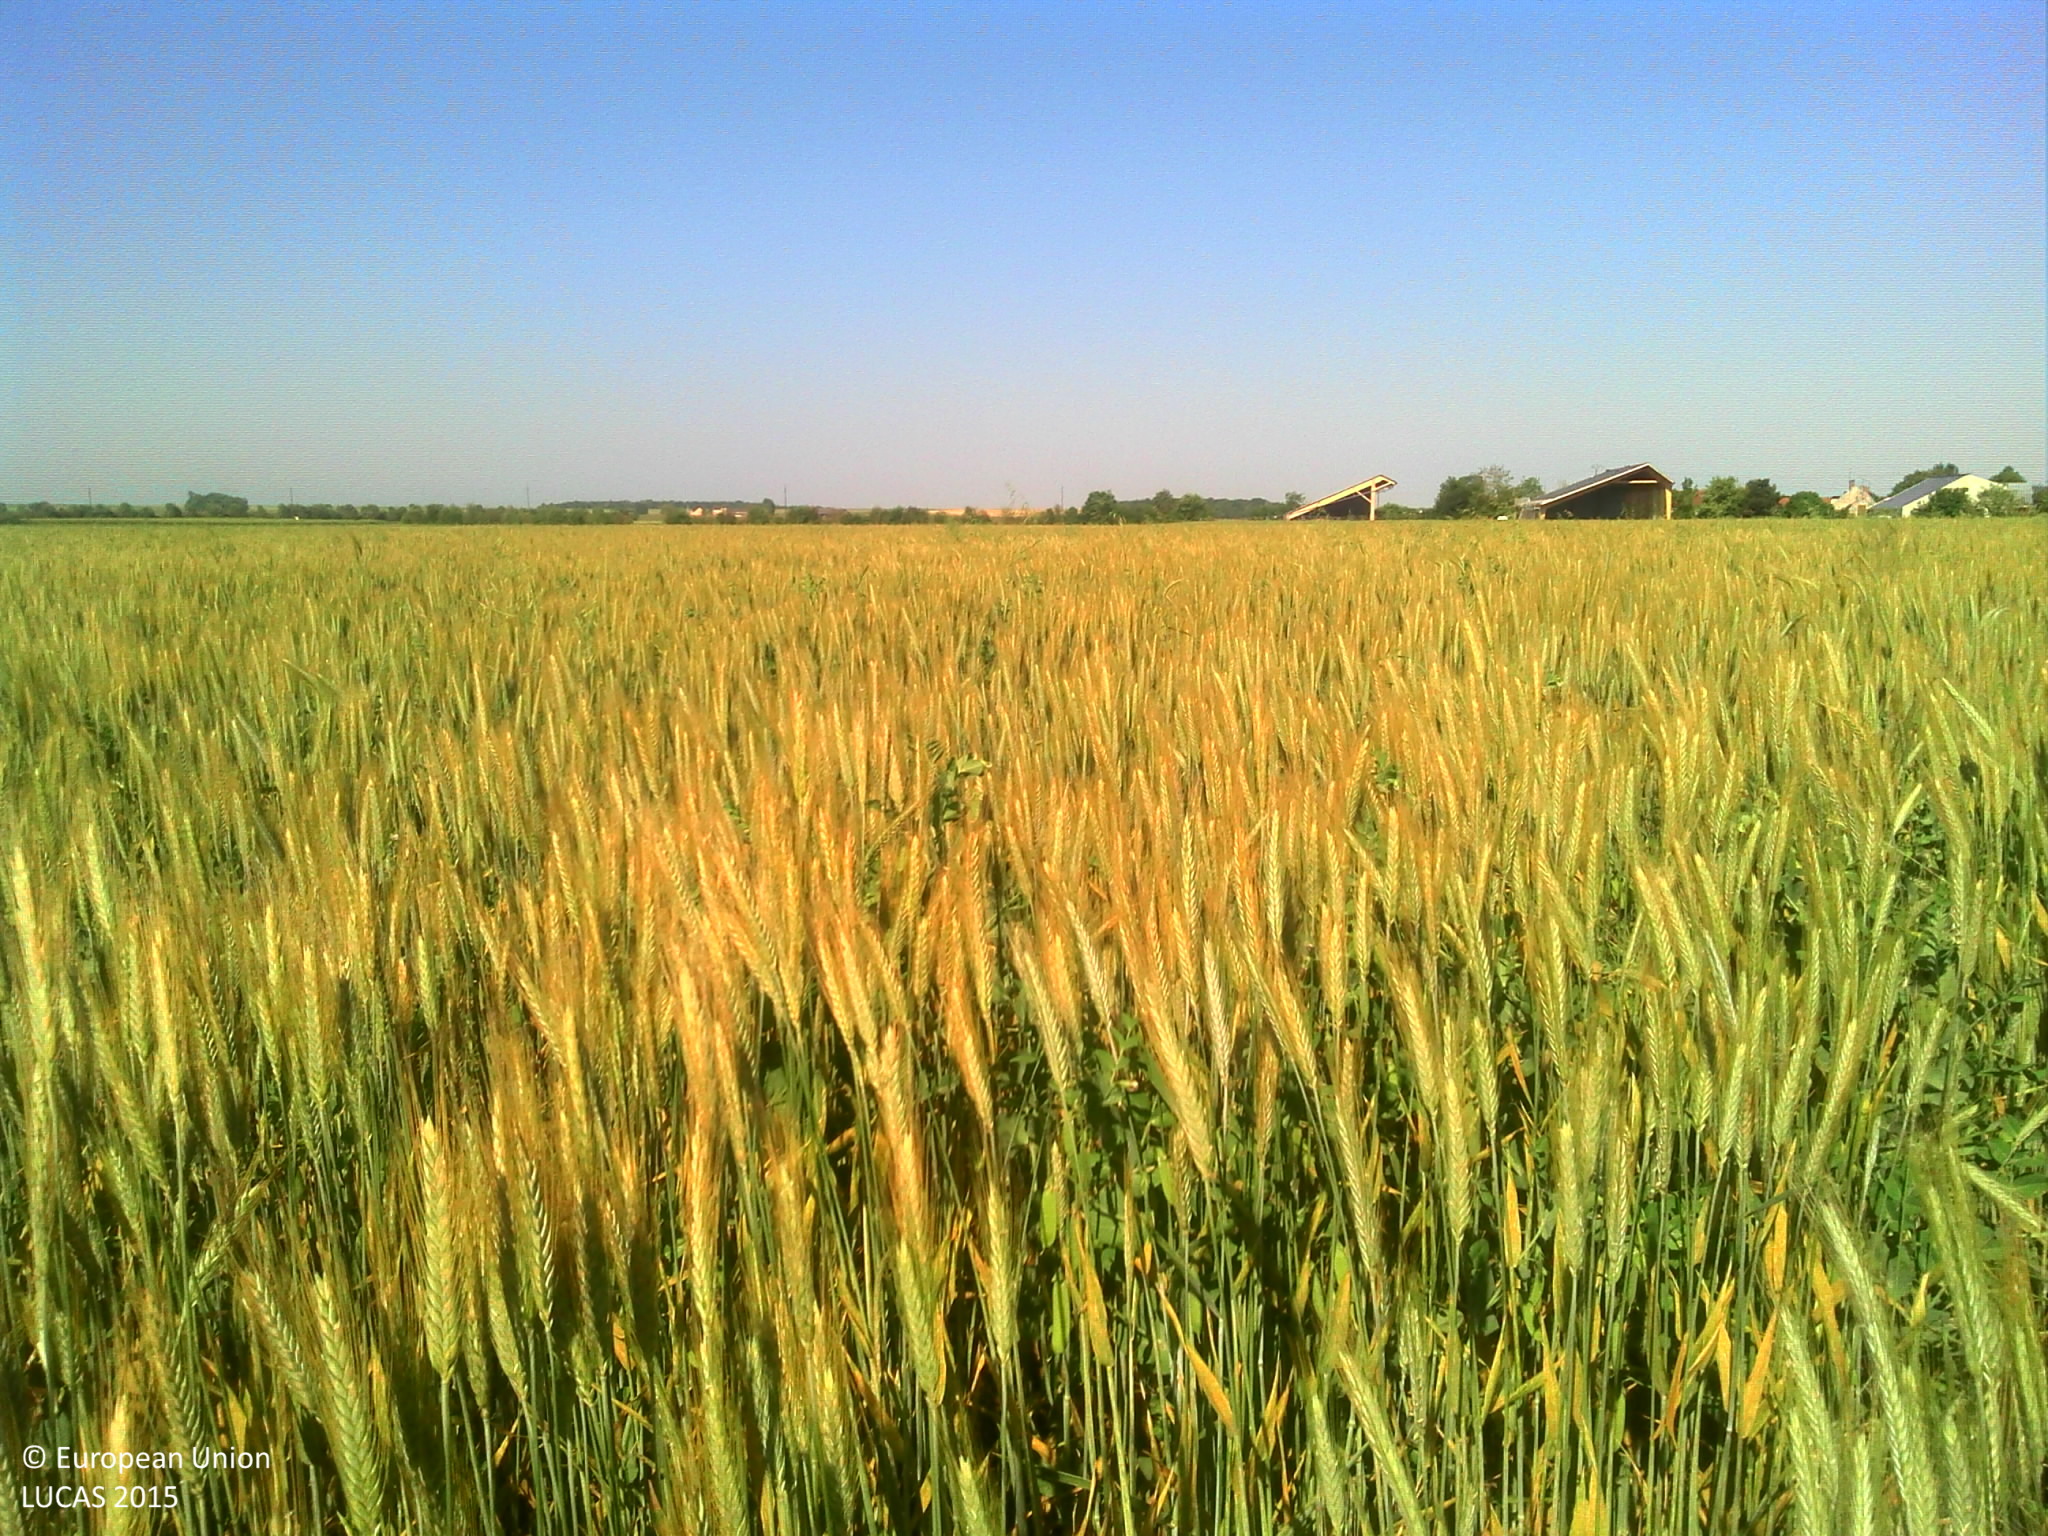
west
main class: Cropland
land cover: Common wheat
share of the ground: > 75 %
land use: Agriculture (excluding fallow land and kitchen gardens)
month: June
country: FR
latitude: 48.1641
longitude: 1.4730
